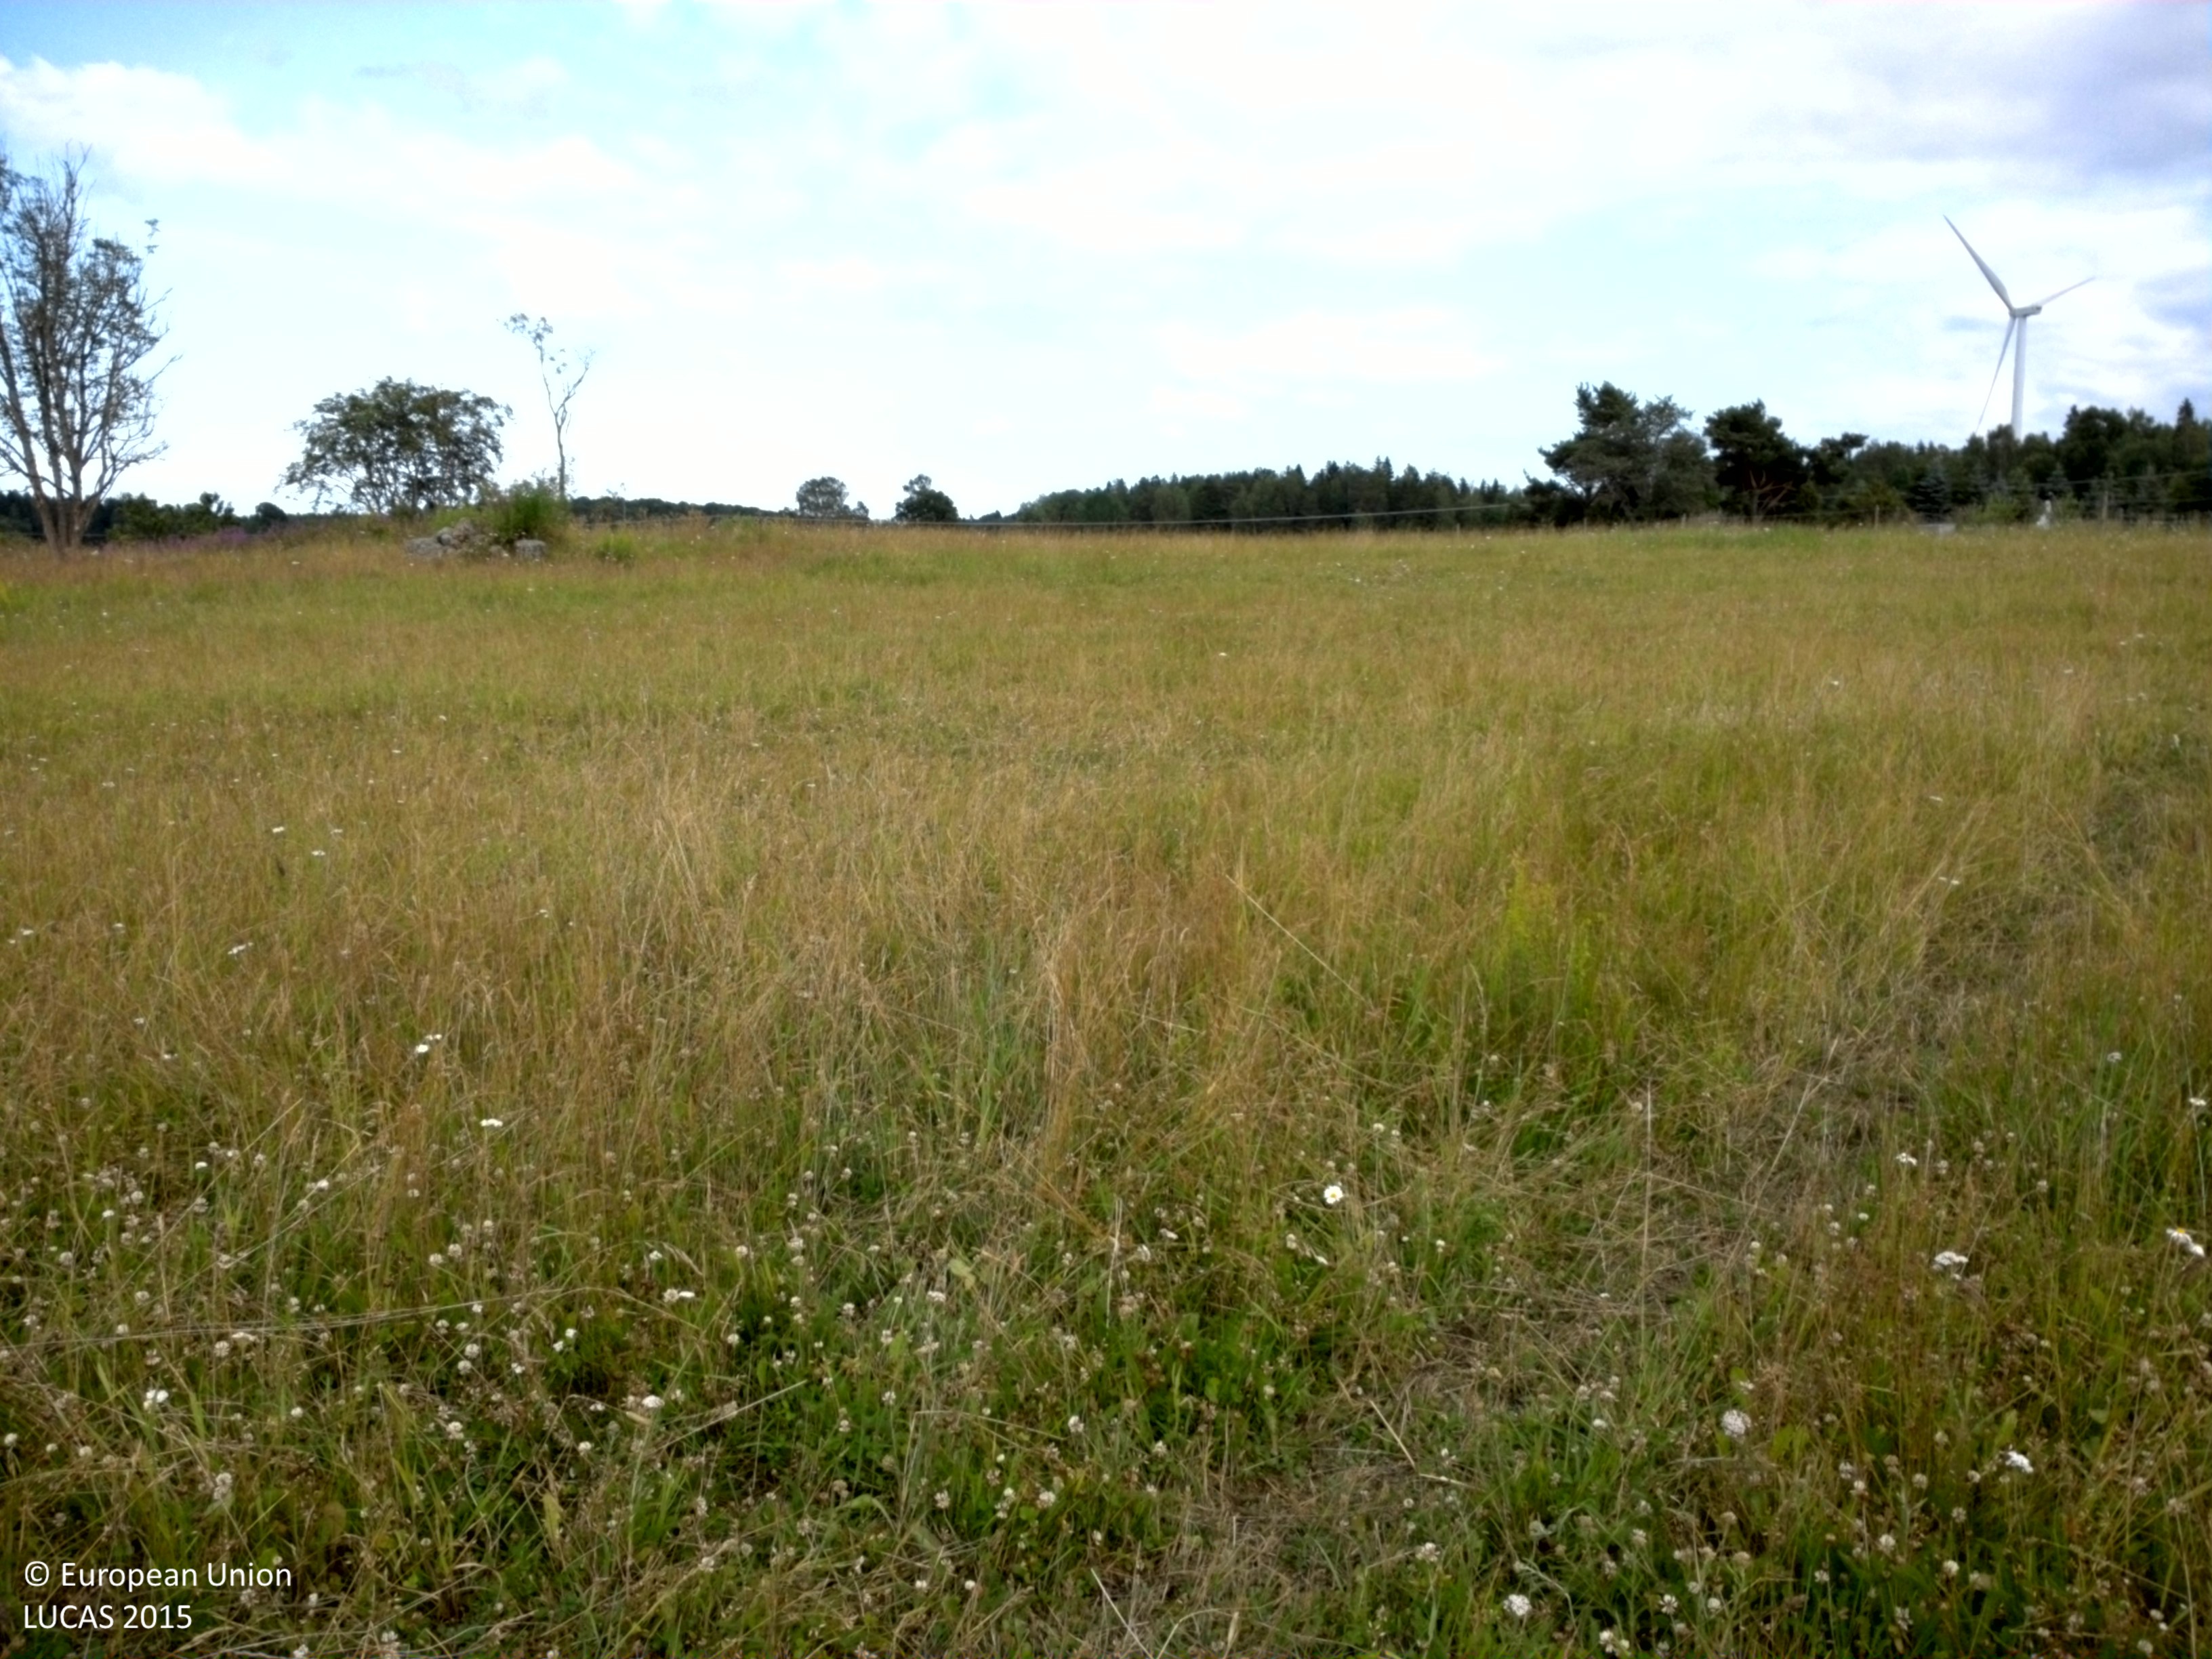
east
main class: Grassland
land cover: Grassland without tree/shrub cover
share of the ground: > 75 %
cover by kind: herbaceous plants 100 %
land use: Agriculture (excluding fallow land and kitchen gardens)
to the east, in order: Grassland without tree/shrub cover; Fences; Grassland without tree/shrub cover; Ditches and canals; Paved roads, cycling and walking lanes; Ditches and canals; Spontaneously vegetated surfaces; Tracks; Ditches and canals; Other leguminous and mixtures for fodder; Ditches and canals; Other leguminous and mixtures for fodder; Electric lines; Other leguminous and mixtures for fodder
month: July
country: SE
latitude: 59.8398
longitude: 18.6895
